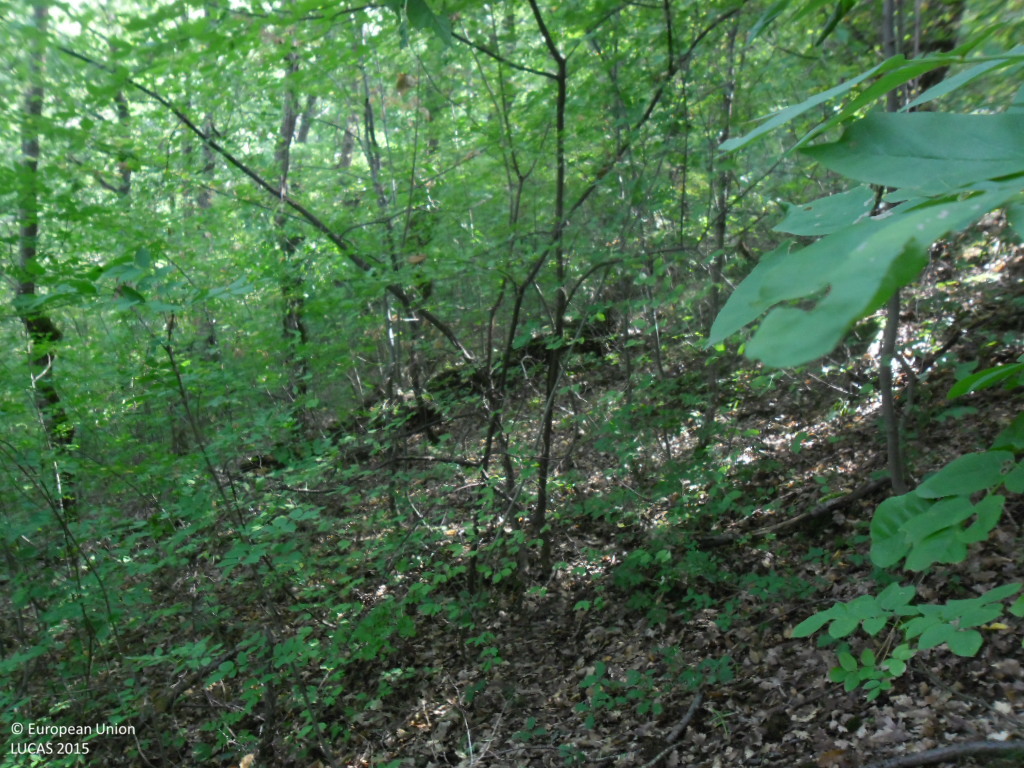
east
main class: Woodland
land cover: Broadleaved woodland
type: mountainous beech forest
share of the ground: > 75 %
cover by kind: broadleaved forest trees 95 %, unconsolidated bare surface 5 %
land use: Forestry
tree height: > 5 m
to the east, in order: Broadleaved woodland
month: September
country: BG
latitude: 41.8675
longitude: 22.9969
